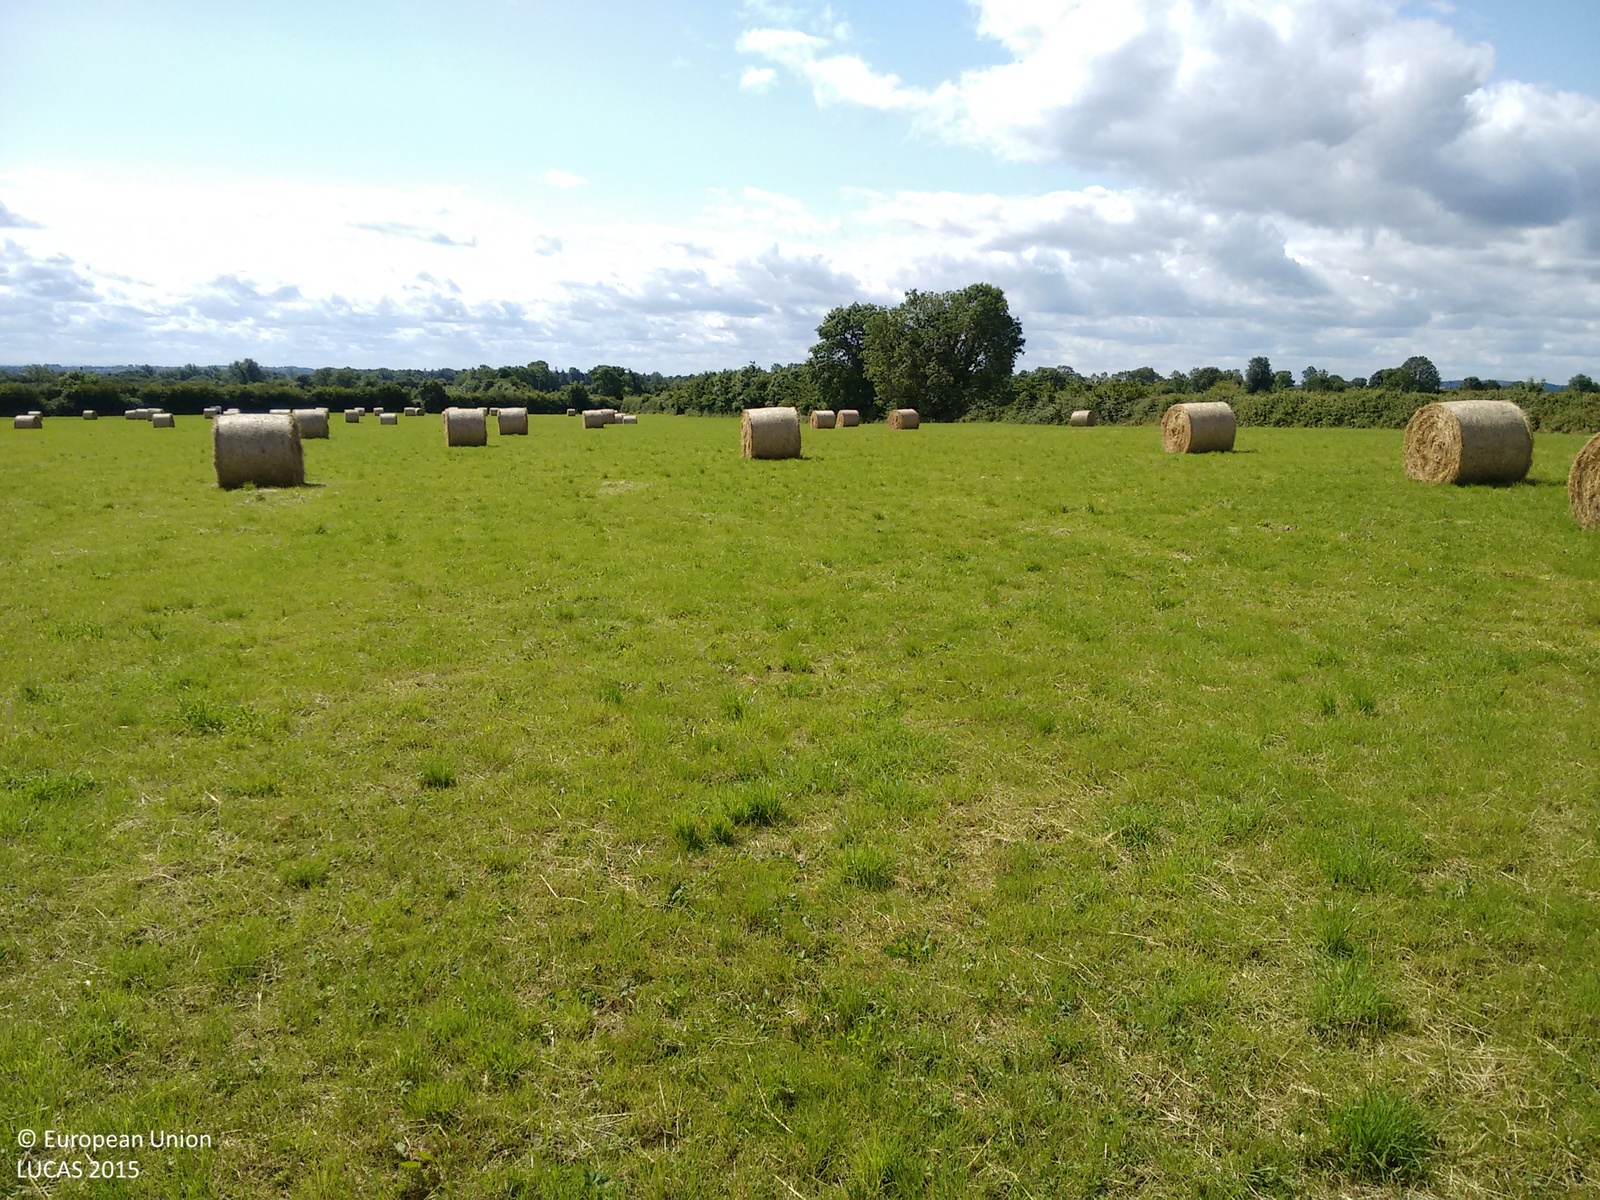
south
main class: Grassland
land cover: Grassland without tree/shrub cover
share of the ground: > 75 %
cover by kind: herbaceous plants 100 %
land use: Agriculture (excluding fallow land and kitchen gardens)
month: July
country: IE
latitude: 53.5585
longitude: -7.9413
